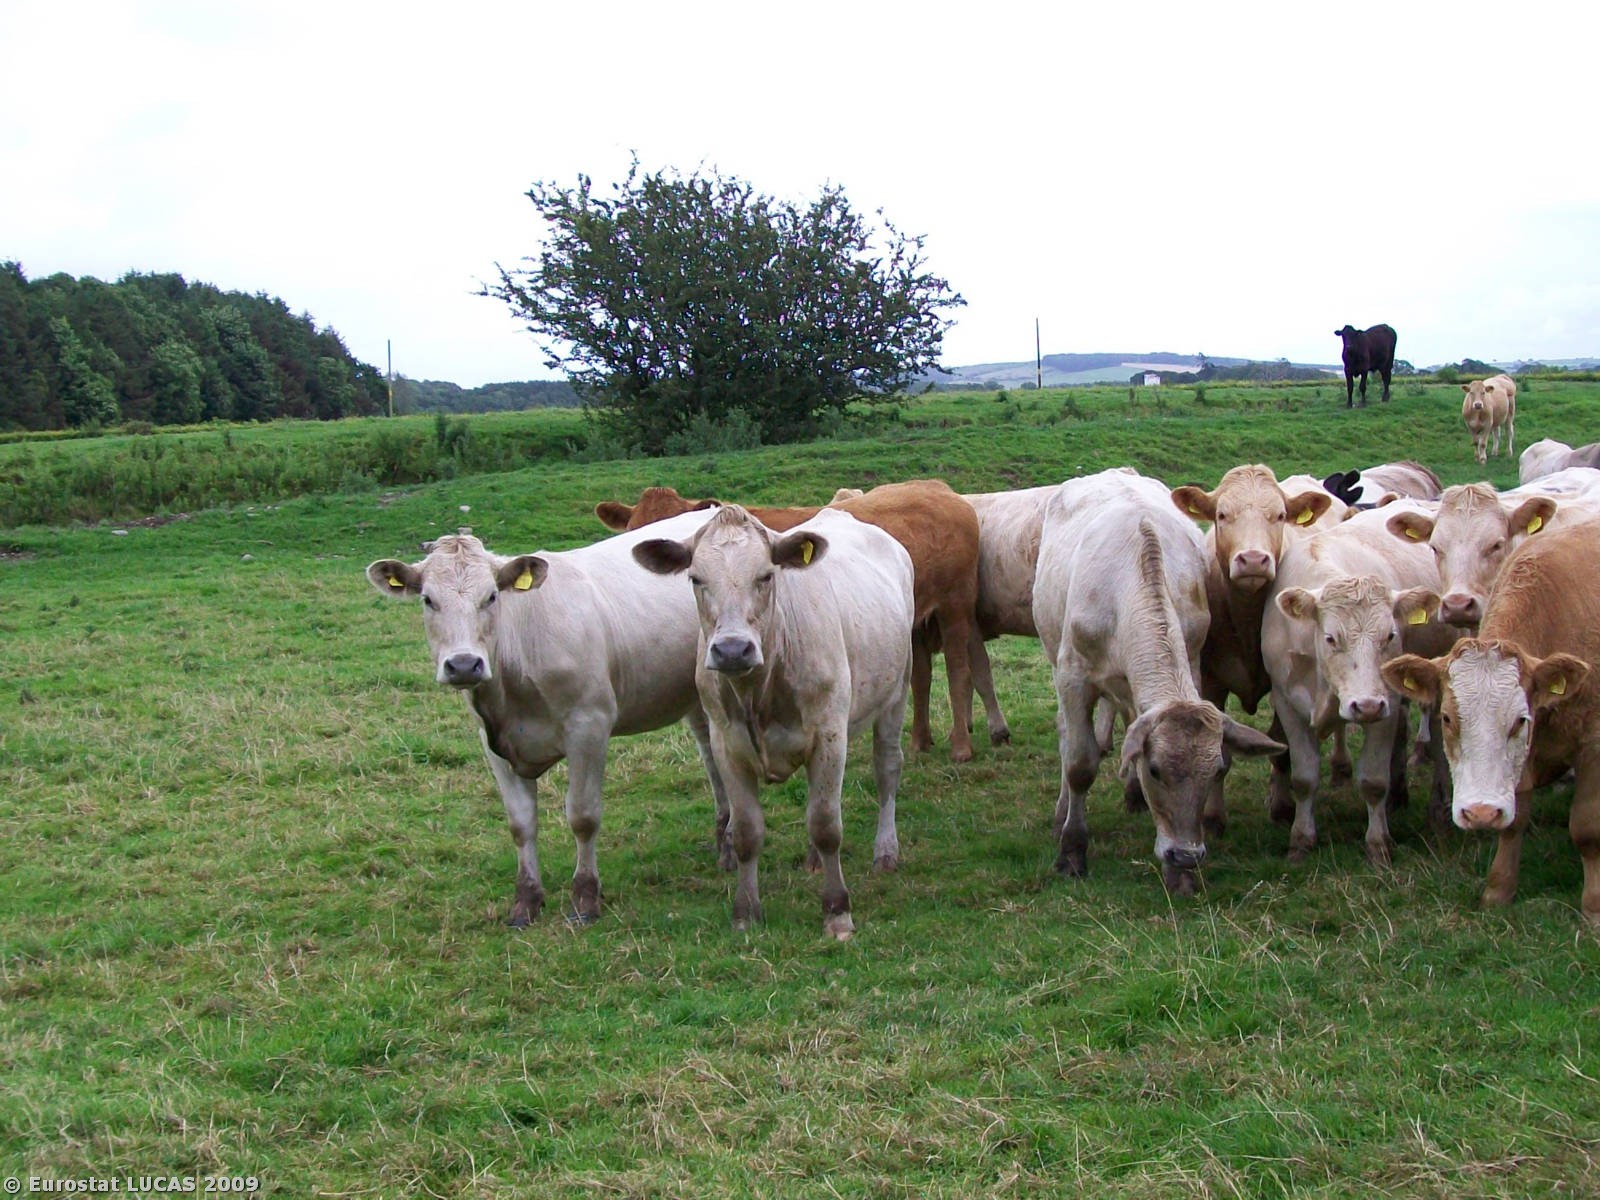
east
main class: Grassland
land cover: Grassland without tree/shrub cover
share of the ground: > 75 %
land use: Agriculture (excluding fallow land and kitchen gardens)
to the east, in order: Grassland without tree/shrub cover; Artificial constructions; Ditches and canals; Single bushes/trees; Artificial constructions; Grassland without tree/shrub cover; Fences; Managed hedges; Grass margins; Paved roads, cycling and walking lanes; Grass margins; Electric lines; Managed hedges; Barley
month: July
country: GB
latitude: 55.0496
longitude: -3.3348
